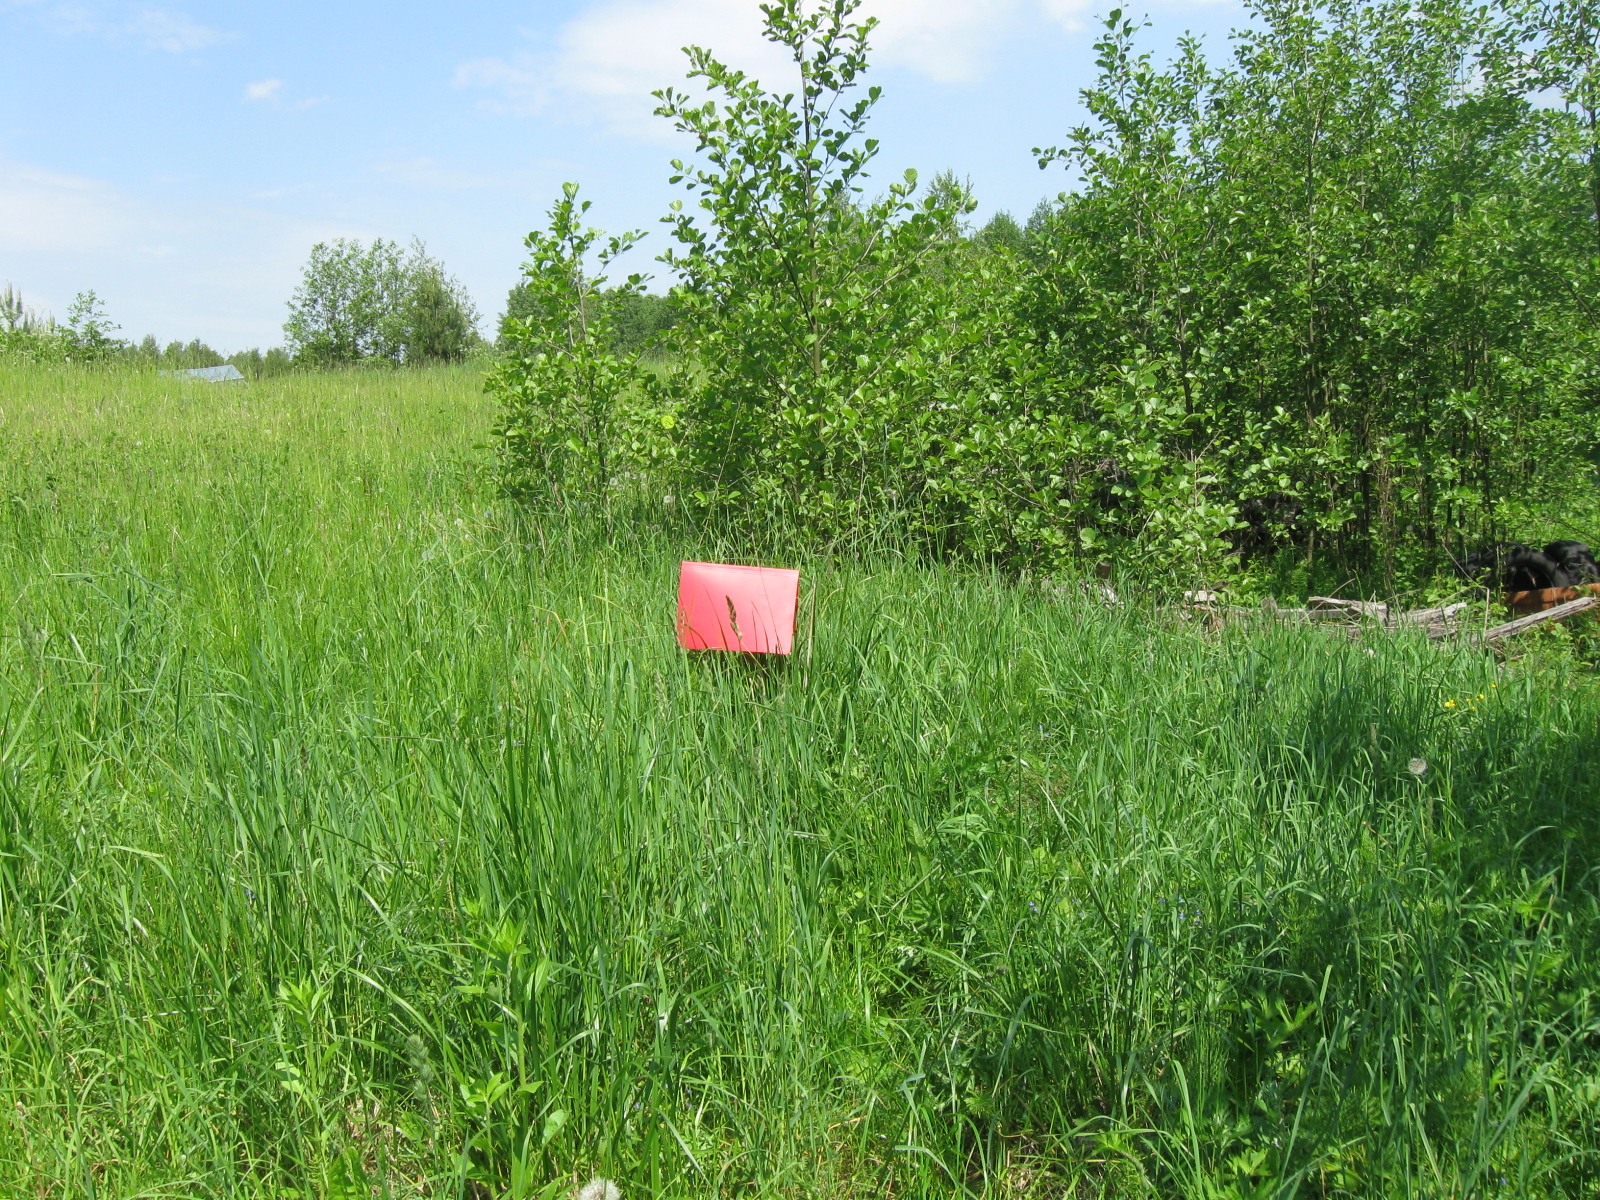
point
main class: Grassland
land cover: Grassland with sparse tree/shrub cover
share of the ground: > 75 %
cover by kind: herbaceous plants 85 %, shrubs 10 %, broadleaved forest trees 5 %
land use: Agriculture (excluding fallow land and kitchen gardens)
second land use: Residential
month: June
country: LT
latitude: 54.2086
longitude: 23.8426
